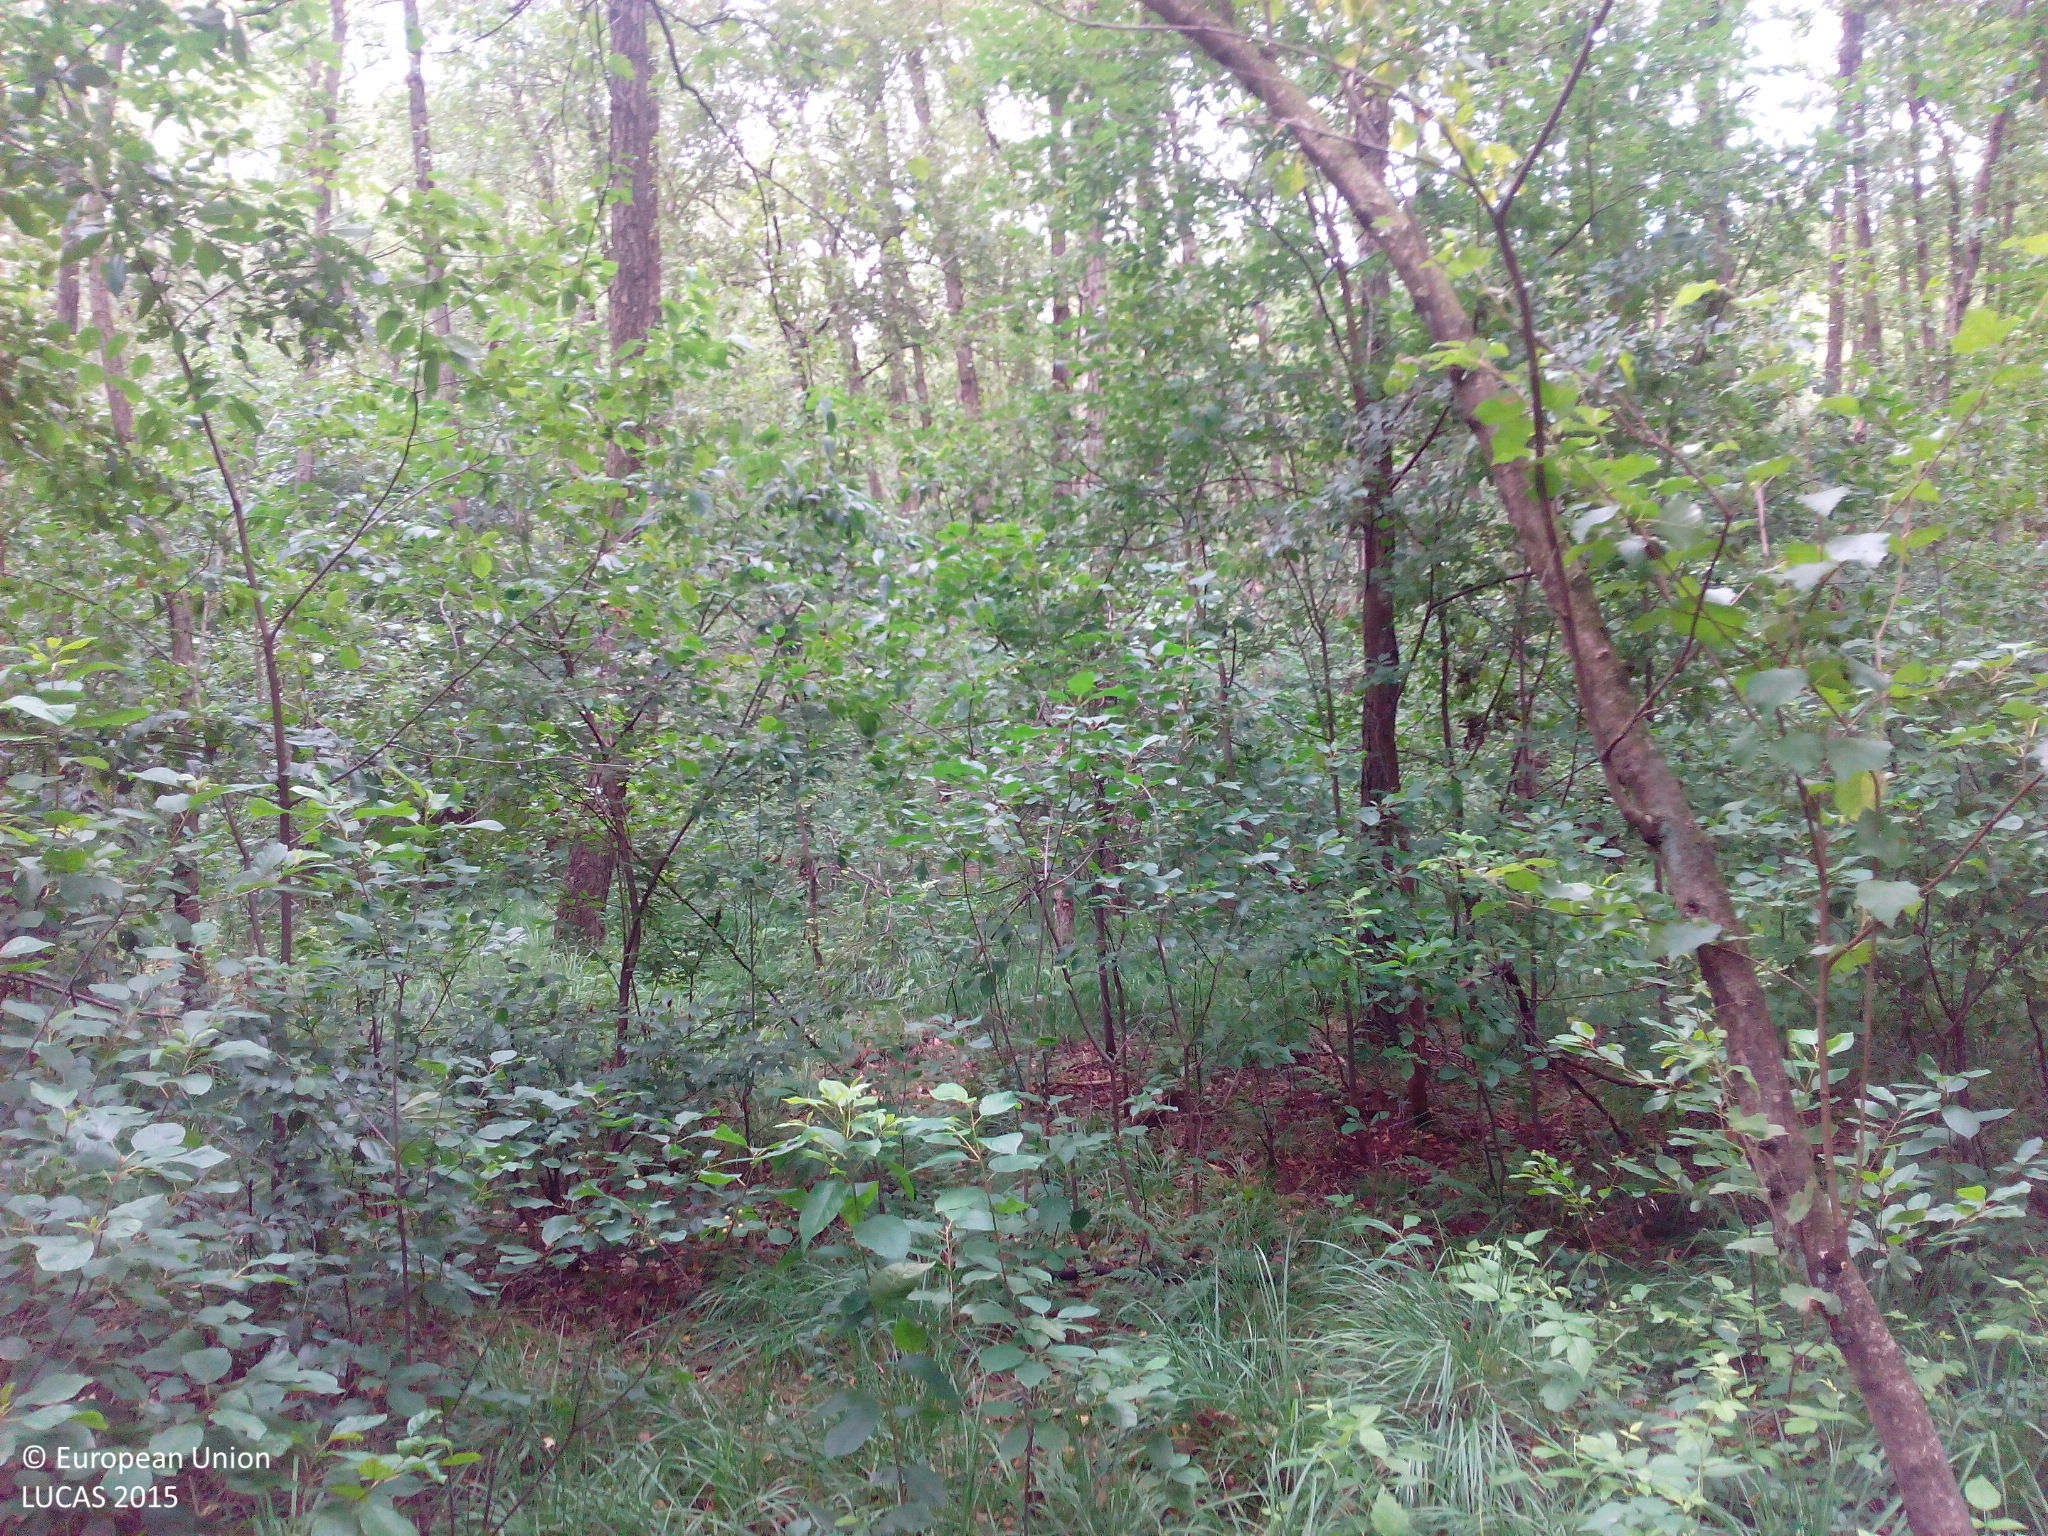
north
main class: Woodland
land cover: Broadleaved woodland
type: mesophytic deciduous forest
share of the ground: > 75 %
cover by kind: broadleaved forest trees 75 %, herbaceous plants 25 %
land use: Forestry
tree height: > 5 m
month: July
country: DE
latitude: 52.1444
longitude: 12.0308
